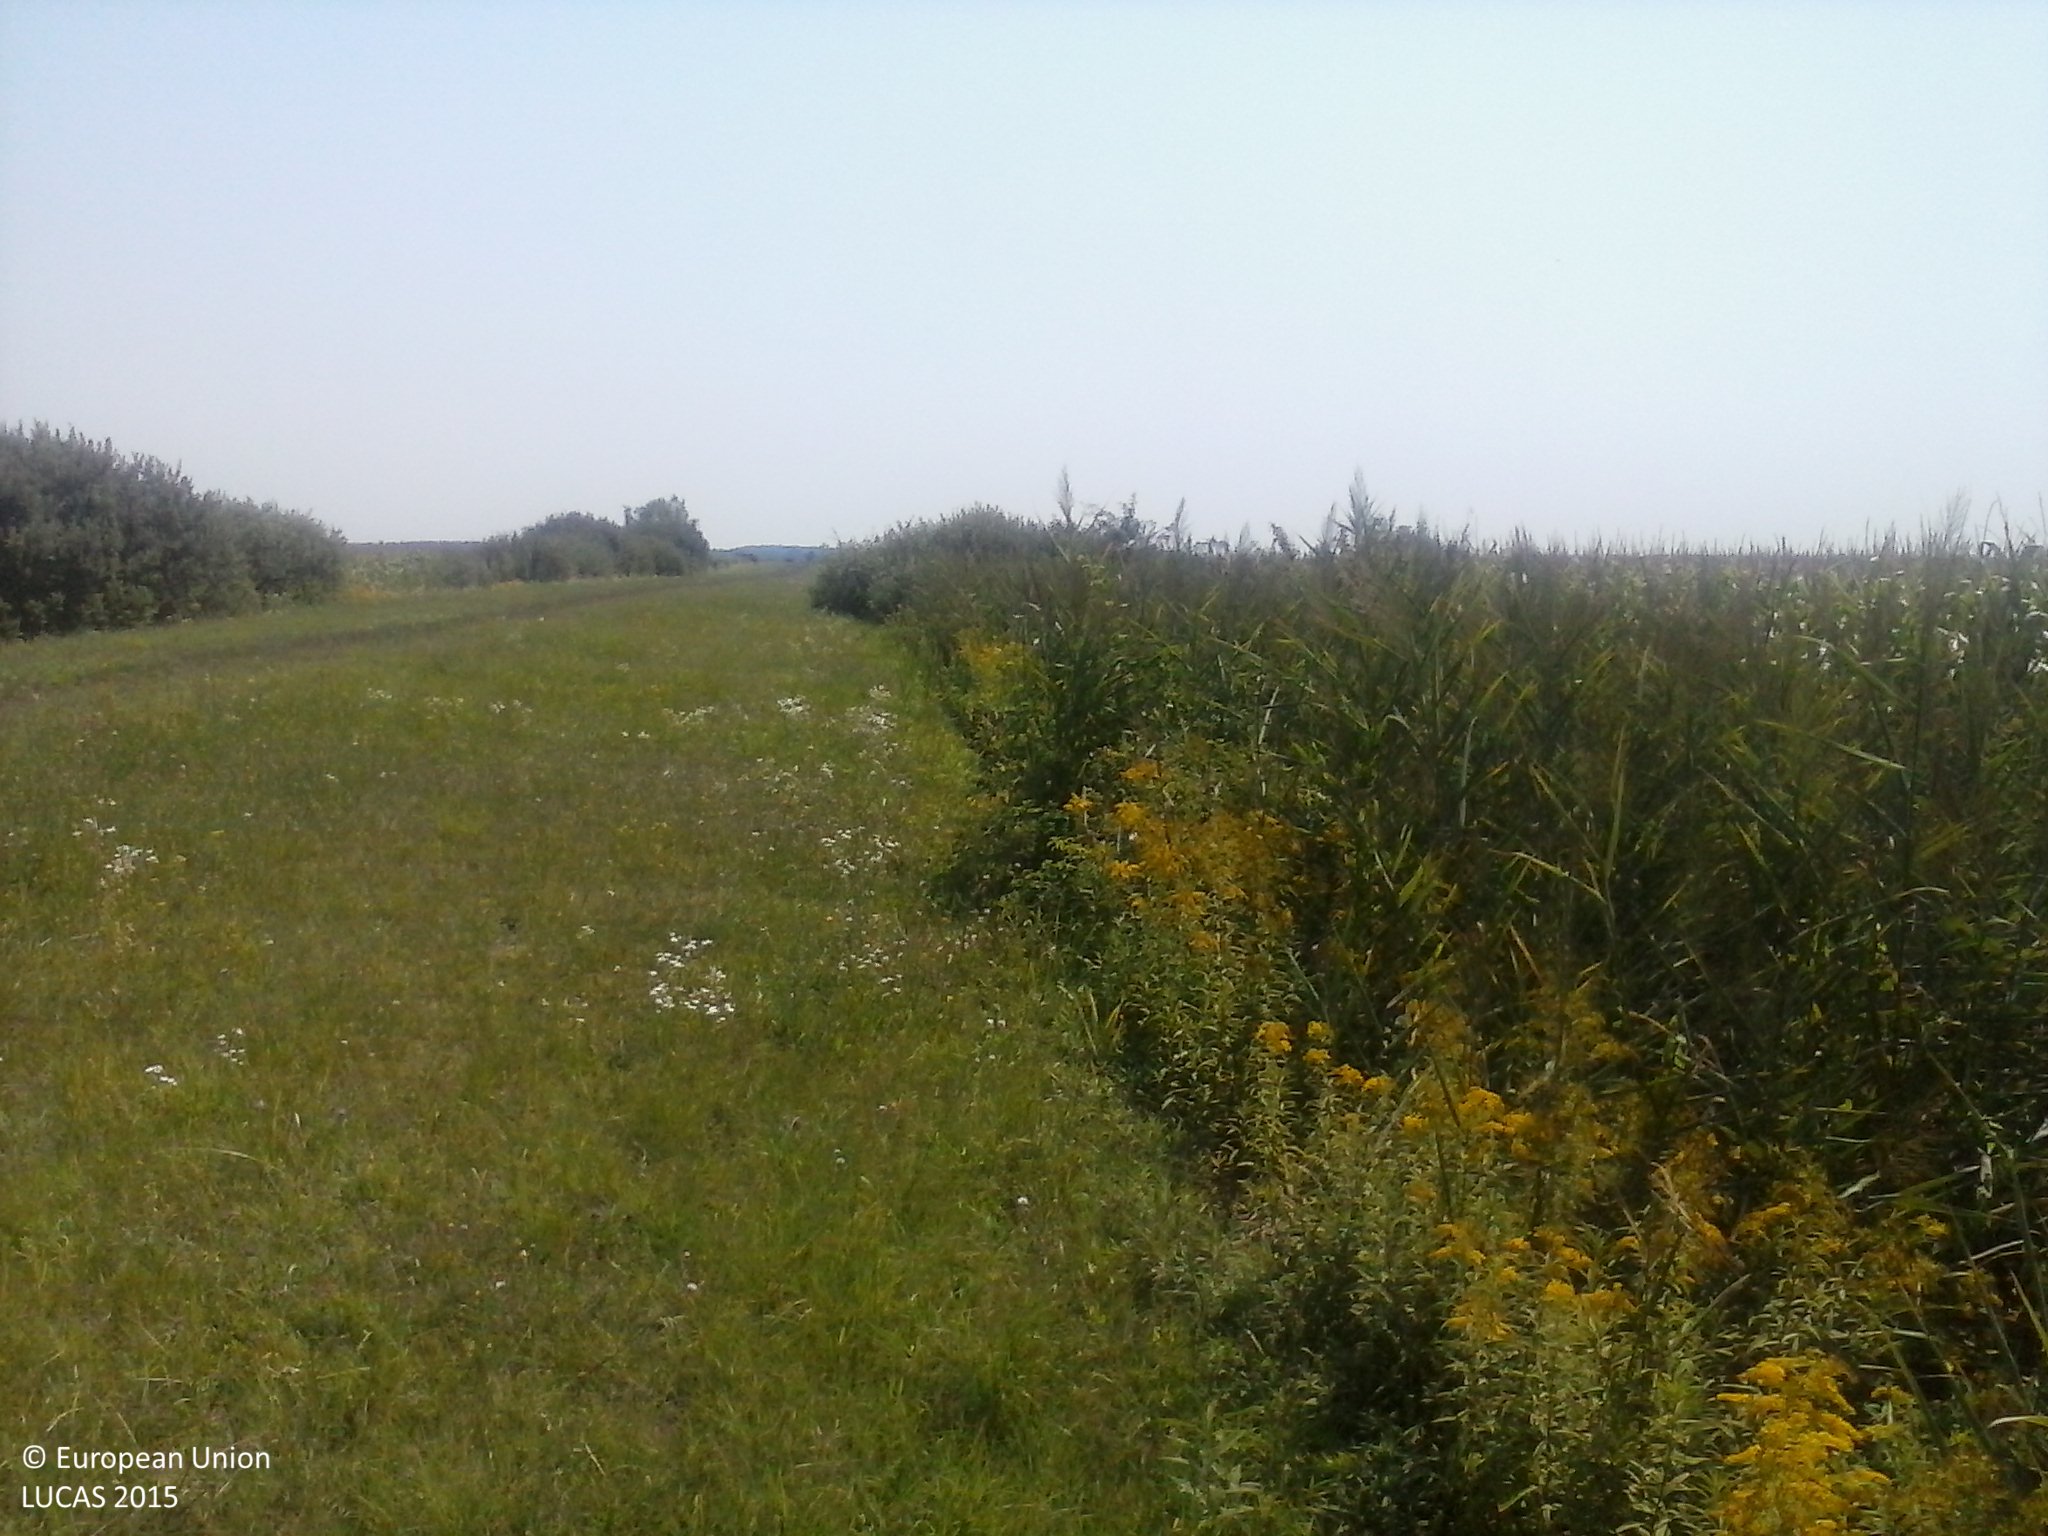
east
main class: Cropland
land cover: Maize
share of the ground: > 75 %
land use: Agriculture (excluding fallow land and kitchen gardens)
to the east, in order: Maize
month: August
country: HU
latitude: 45.9313
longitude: 17.9105
